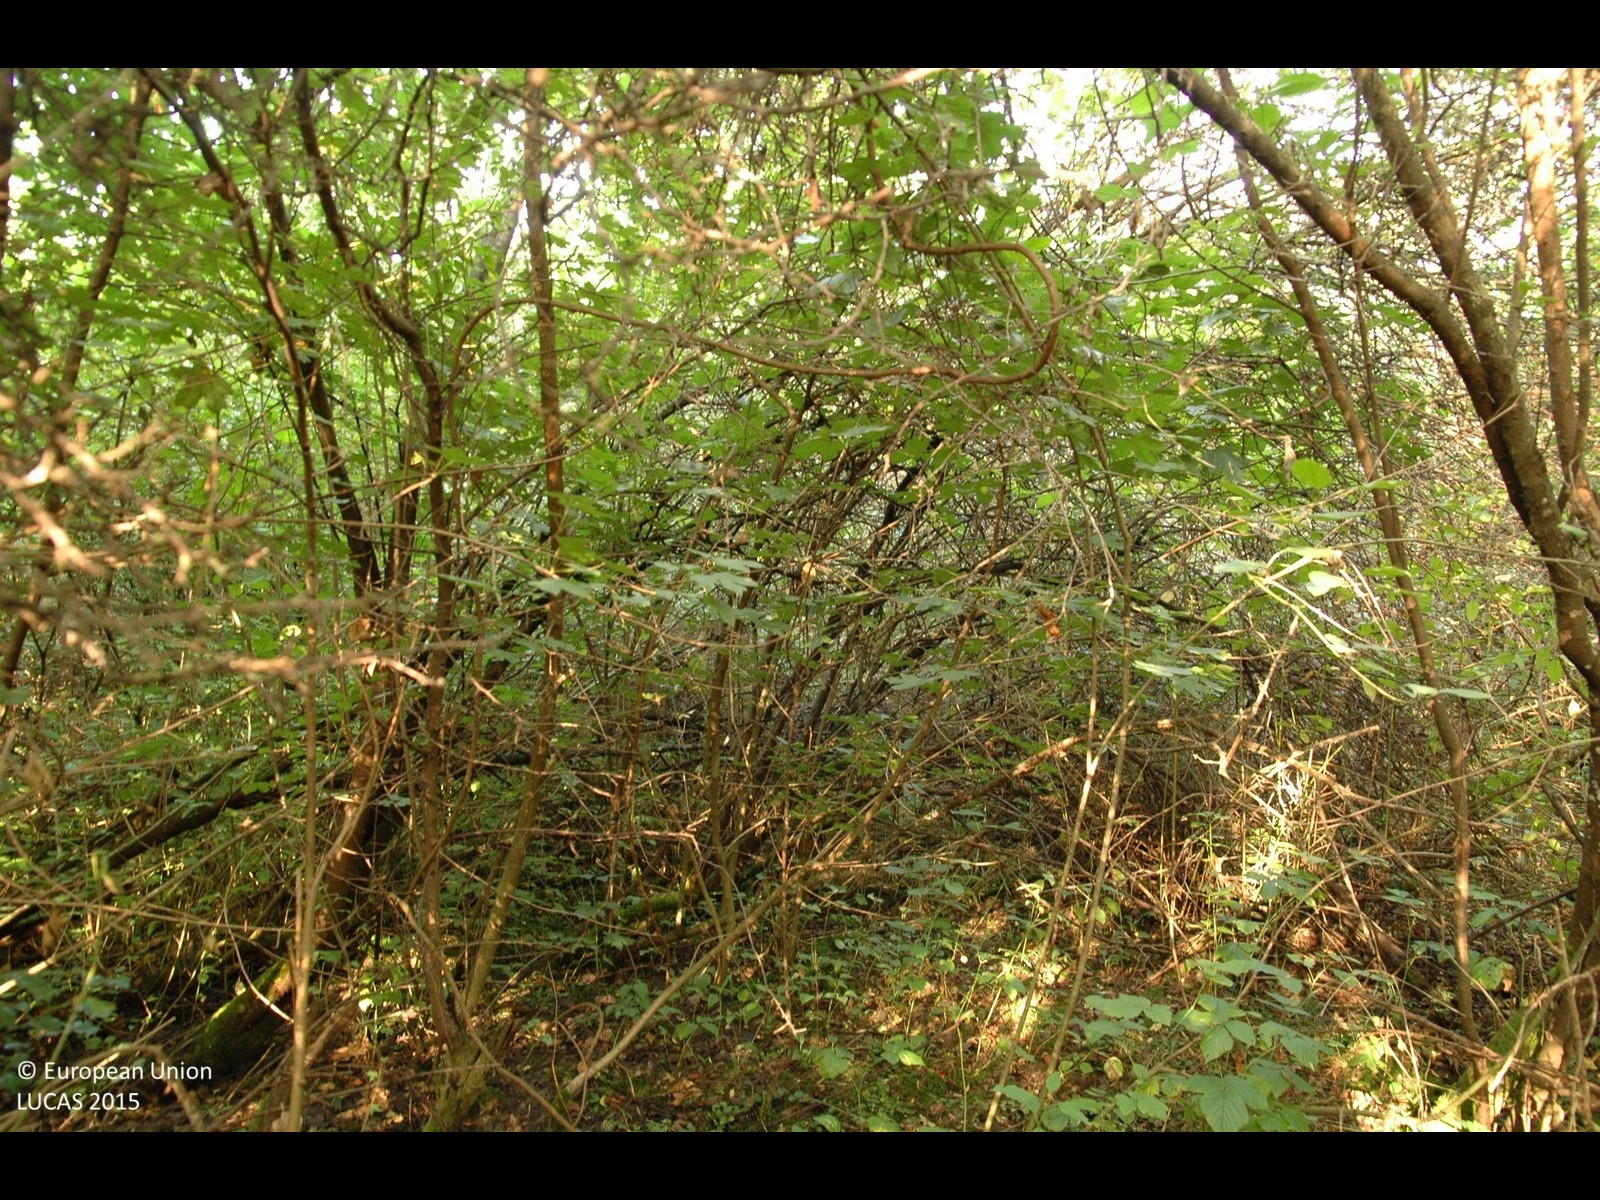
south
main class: Shrubland
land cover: Shrubland with sparse tree cover
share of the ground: > 75 %
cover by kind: shrubs 95 %, broadleaved forest trees 5 %
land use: Semi-natural and natural areas not in use
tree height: > 5 m
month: August
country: HR
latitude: 45.8152
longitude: 16.1113
